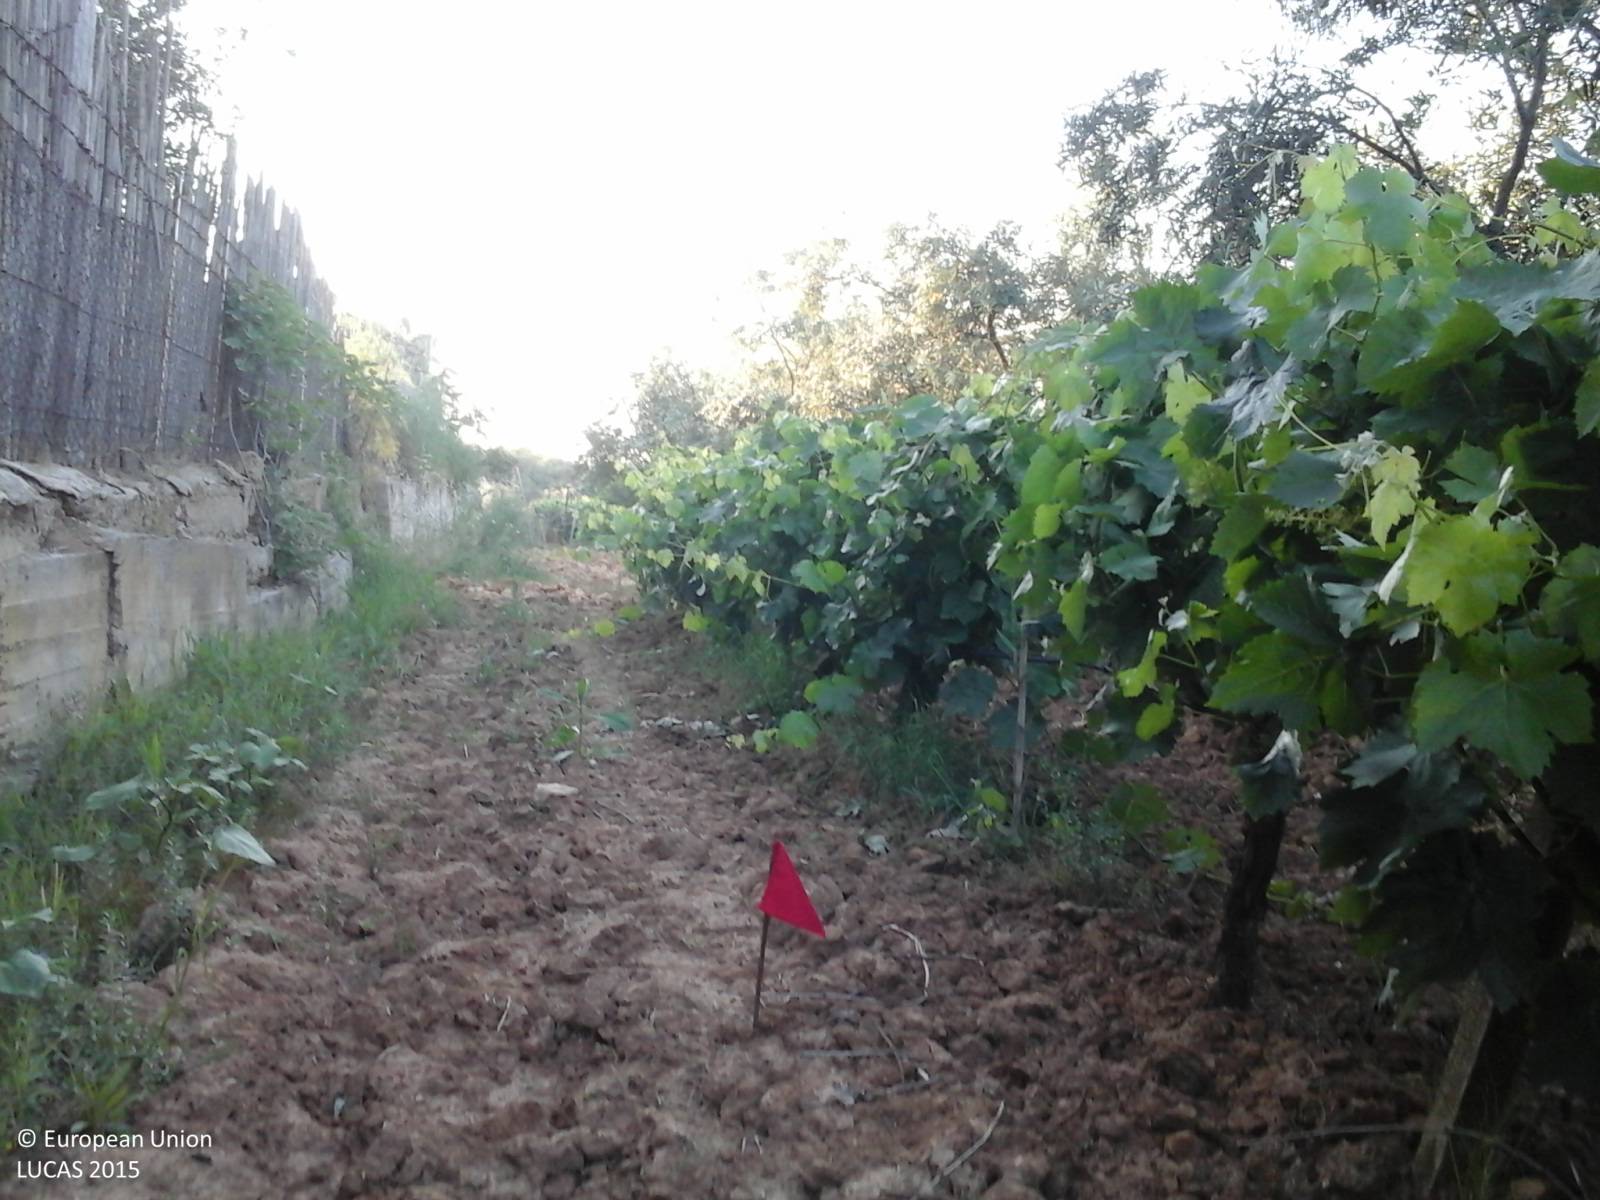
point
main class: Cropland
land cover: Vineyards
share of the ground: 25 - 50 %
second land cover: Olive groves
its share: > 75 %
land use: Agriculture (excluding fallow land and kitchen gardens)
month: June
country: IT
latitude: 38.0069
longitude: 13.0645
